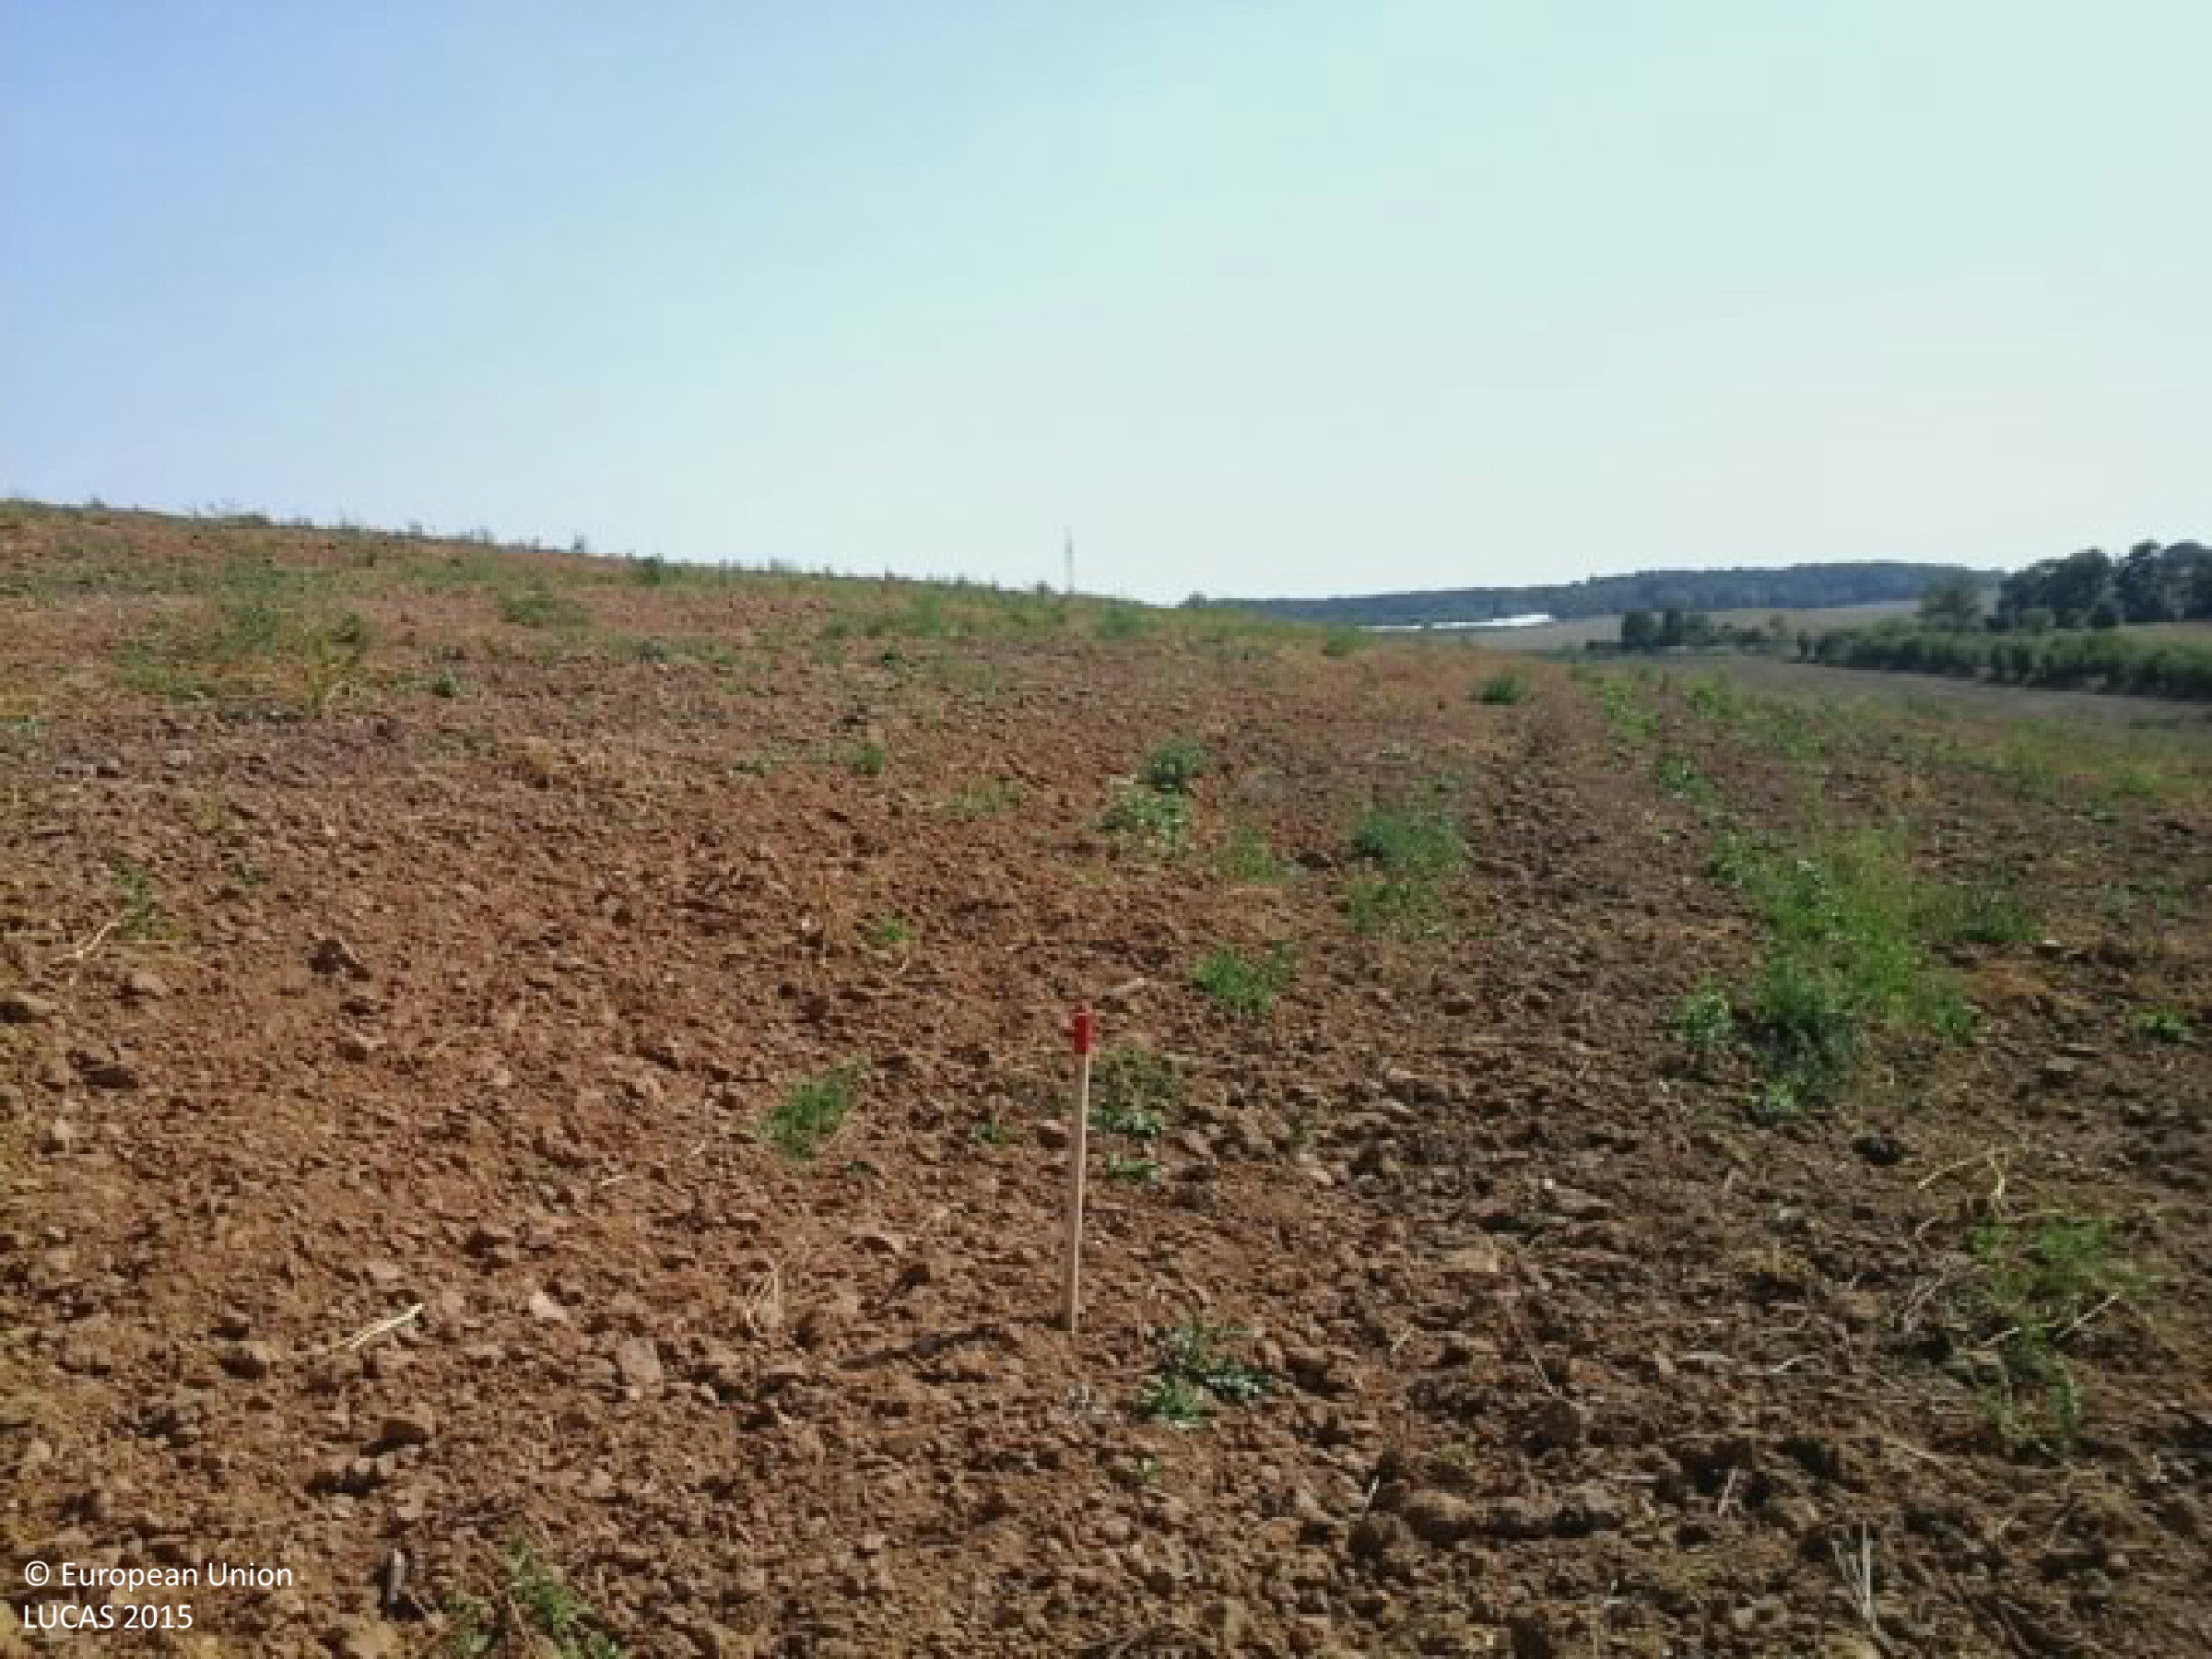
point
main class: Grassland
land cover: Spontaneously vegetated surfaces
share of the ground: 10 - 25 %
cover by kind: unconsolidated bare surface 90 %, herbaceous plants 10 %
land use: Fallow land
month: May
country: HU
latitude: 46.3119
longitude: 17.6535
